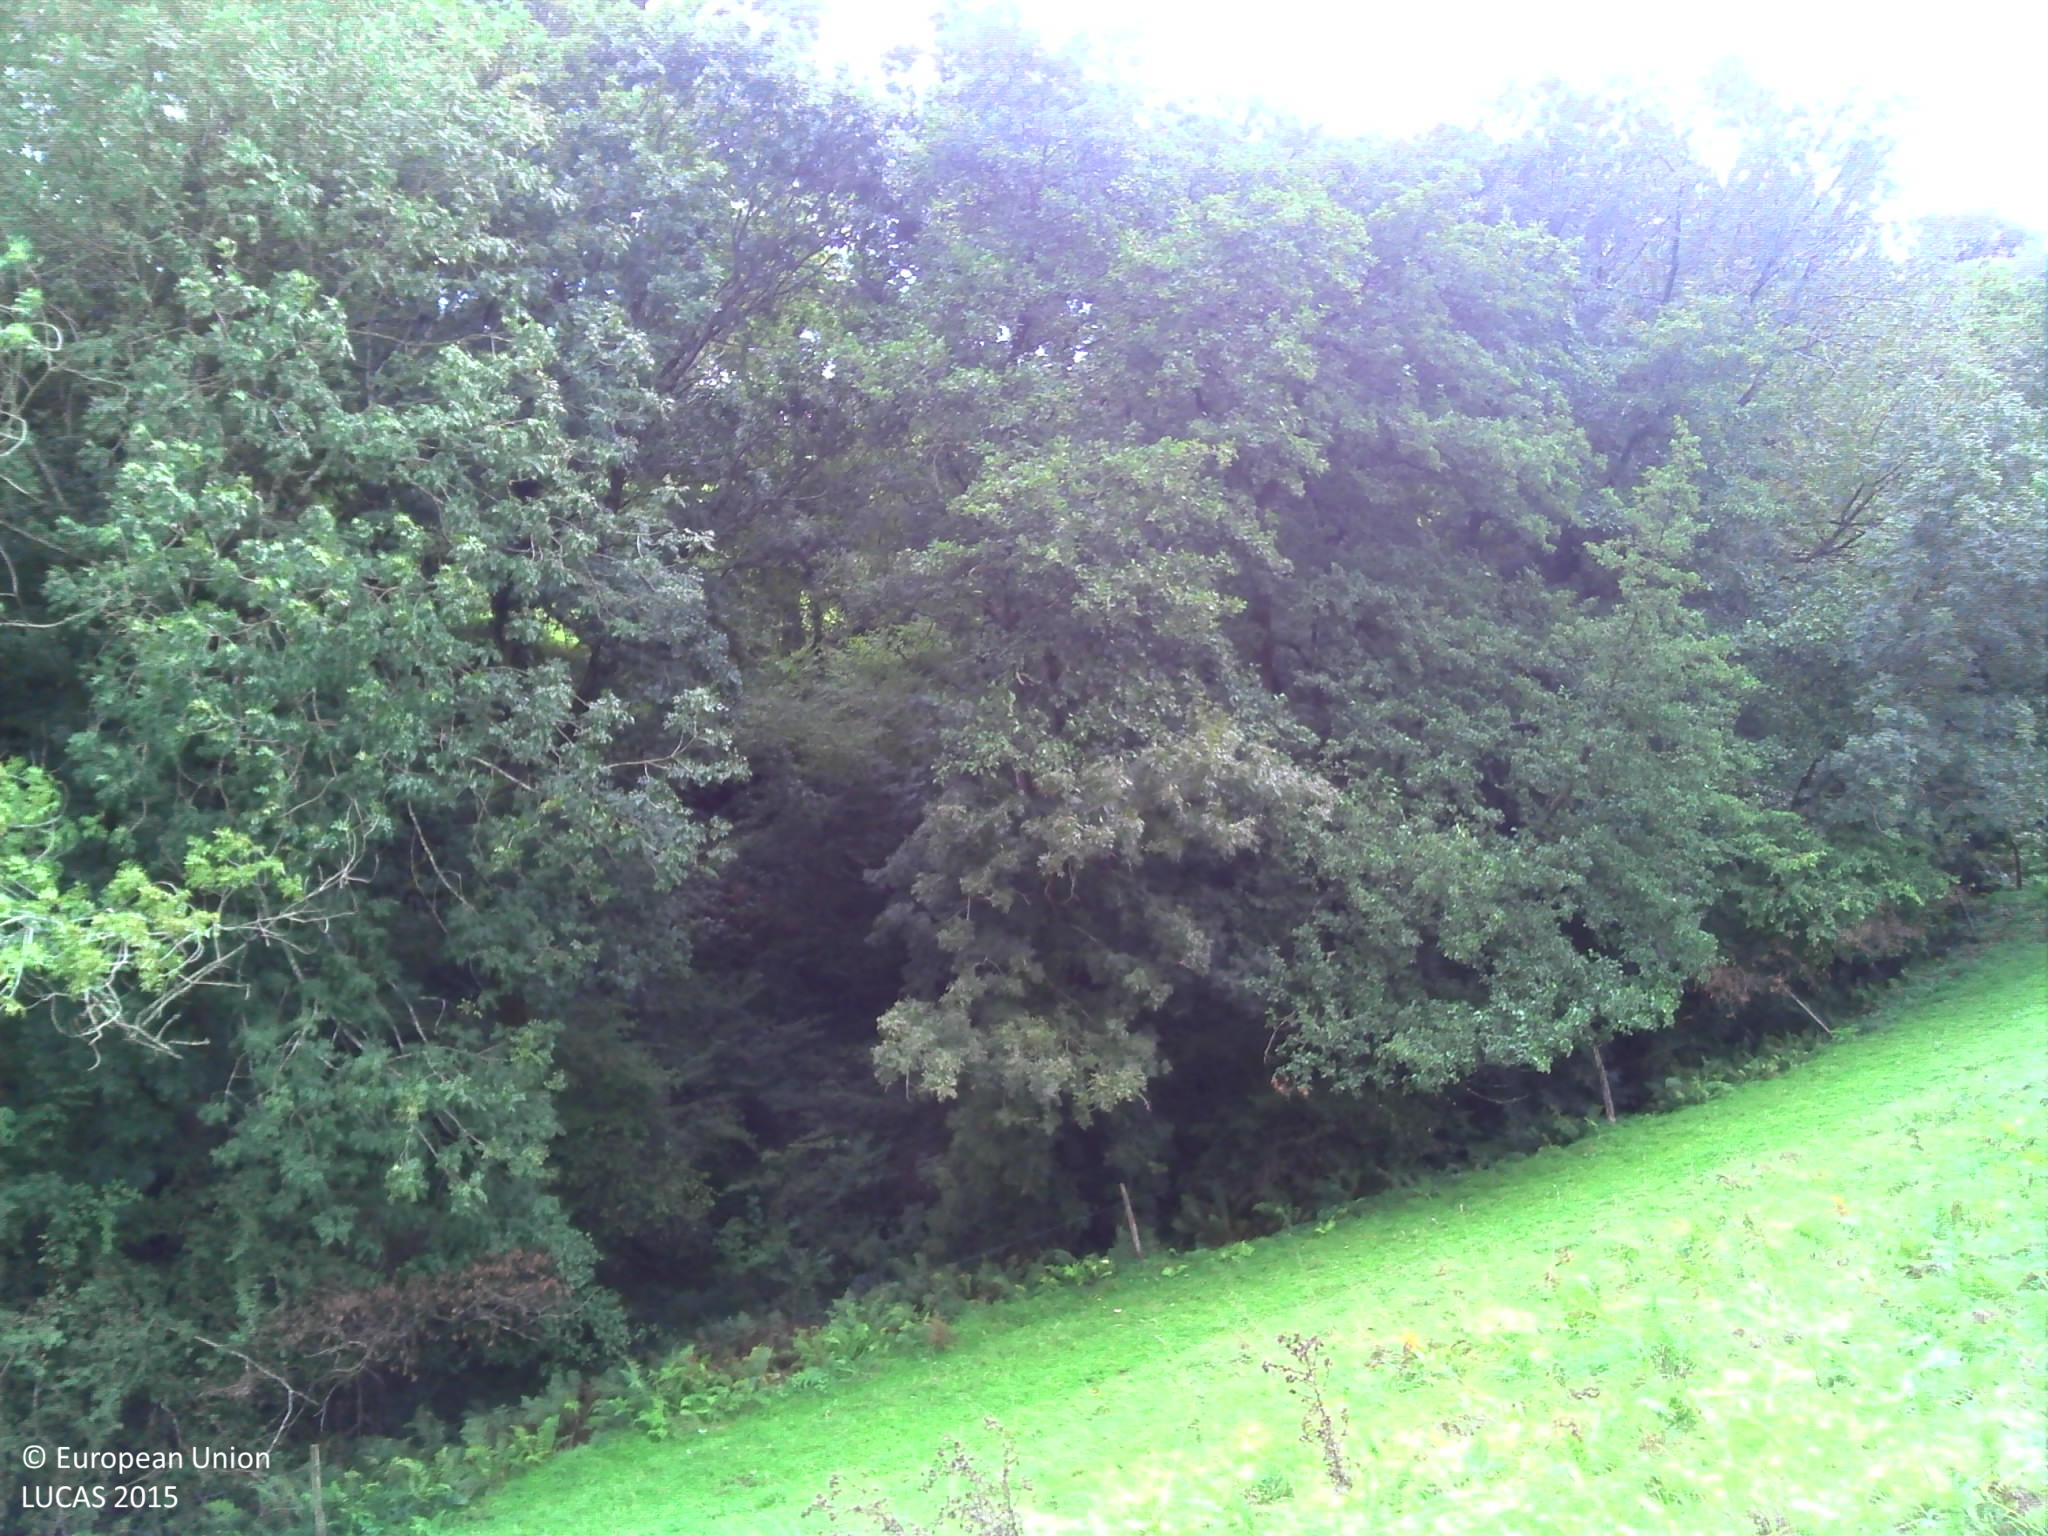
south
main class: Grassland
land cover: Grassland without tree/shrub cover
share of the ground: > 75 %
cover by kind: herbaceous plants 95 %, shrubs 5 %
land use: Agriculture (excluding fallow land and kitchen gardens)
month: September
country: FR
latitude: 43.3942
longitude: -0.7142
